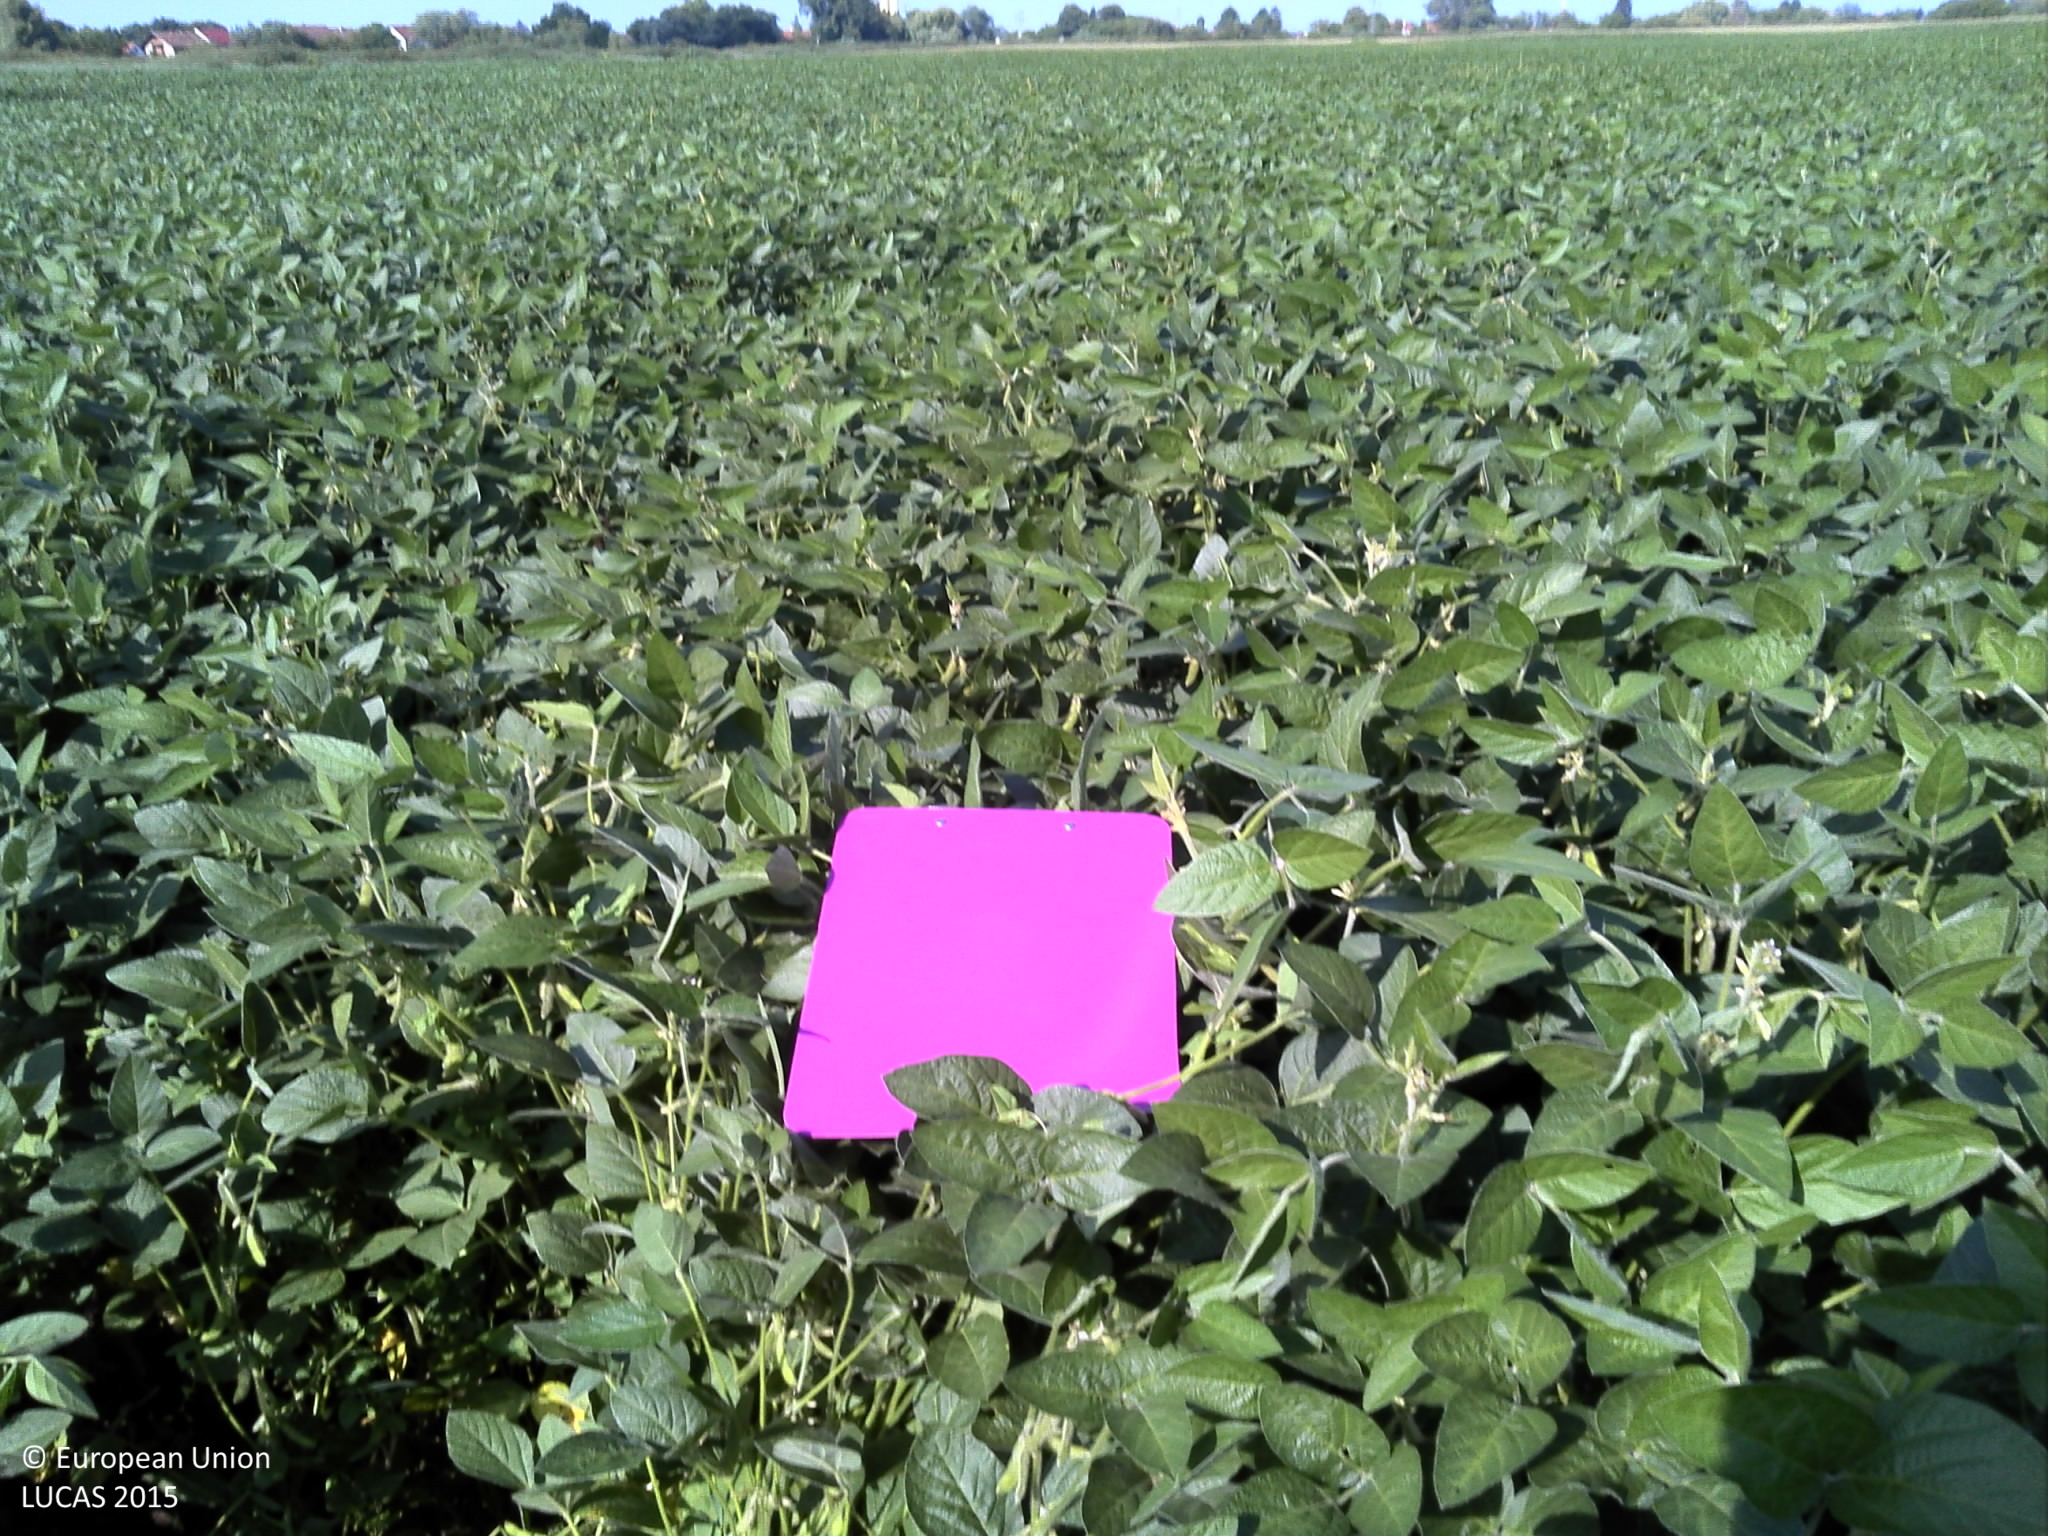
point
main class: Cropland
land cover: Soya
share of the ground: > 75 %
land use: Agriculture (excluding fallow land and kitchen gardens)
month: August
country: HR
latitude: 45.4709
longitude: 16.4318
